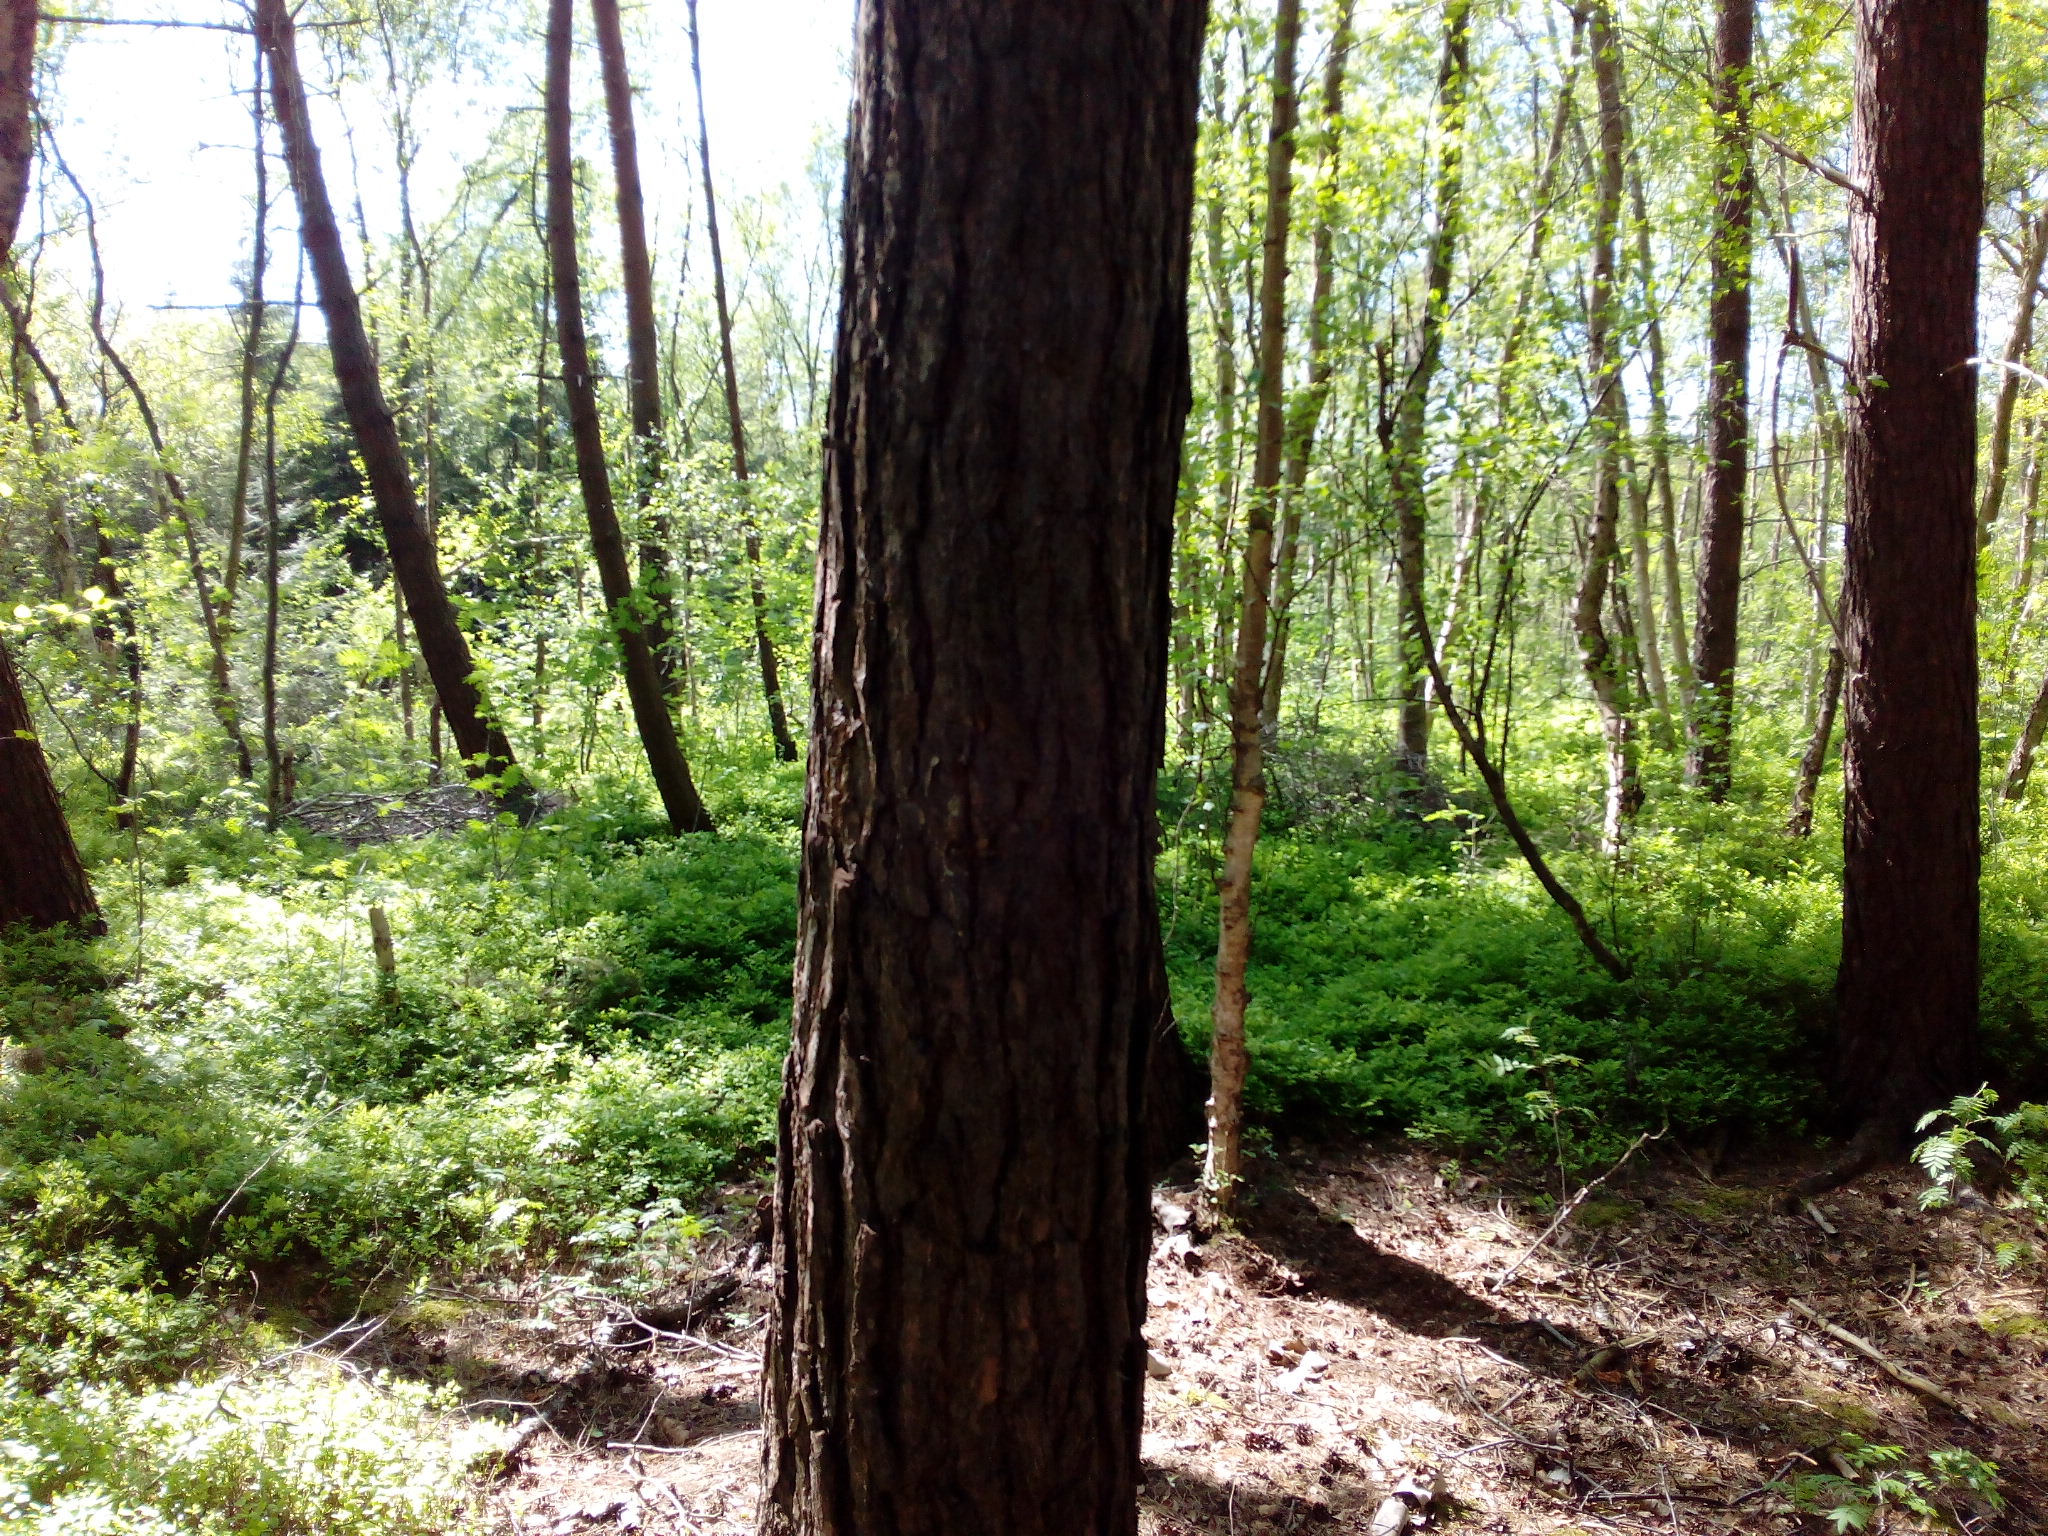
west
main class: Woodland
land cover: Pine dominated mixed woodland
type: hemiboreal forest and nemoral coniferous forest and mixed broadleaved-coniferous forest
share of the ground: > 75 %
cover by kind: coniferous forest trees 60 %, broadleaved forest trees 25 %, herbaceous plants 10 %, unconsolidated bare surface 5 %
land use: Forestry
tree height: > 5 m
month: May
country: DE
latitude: 52.4313
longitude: 9.8971
